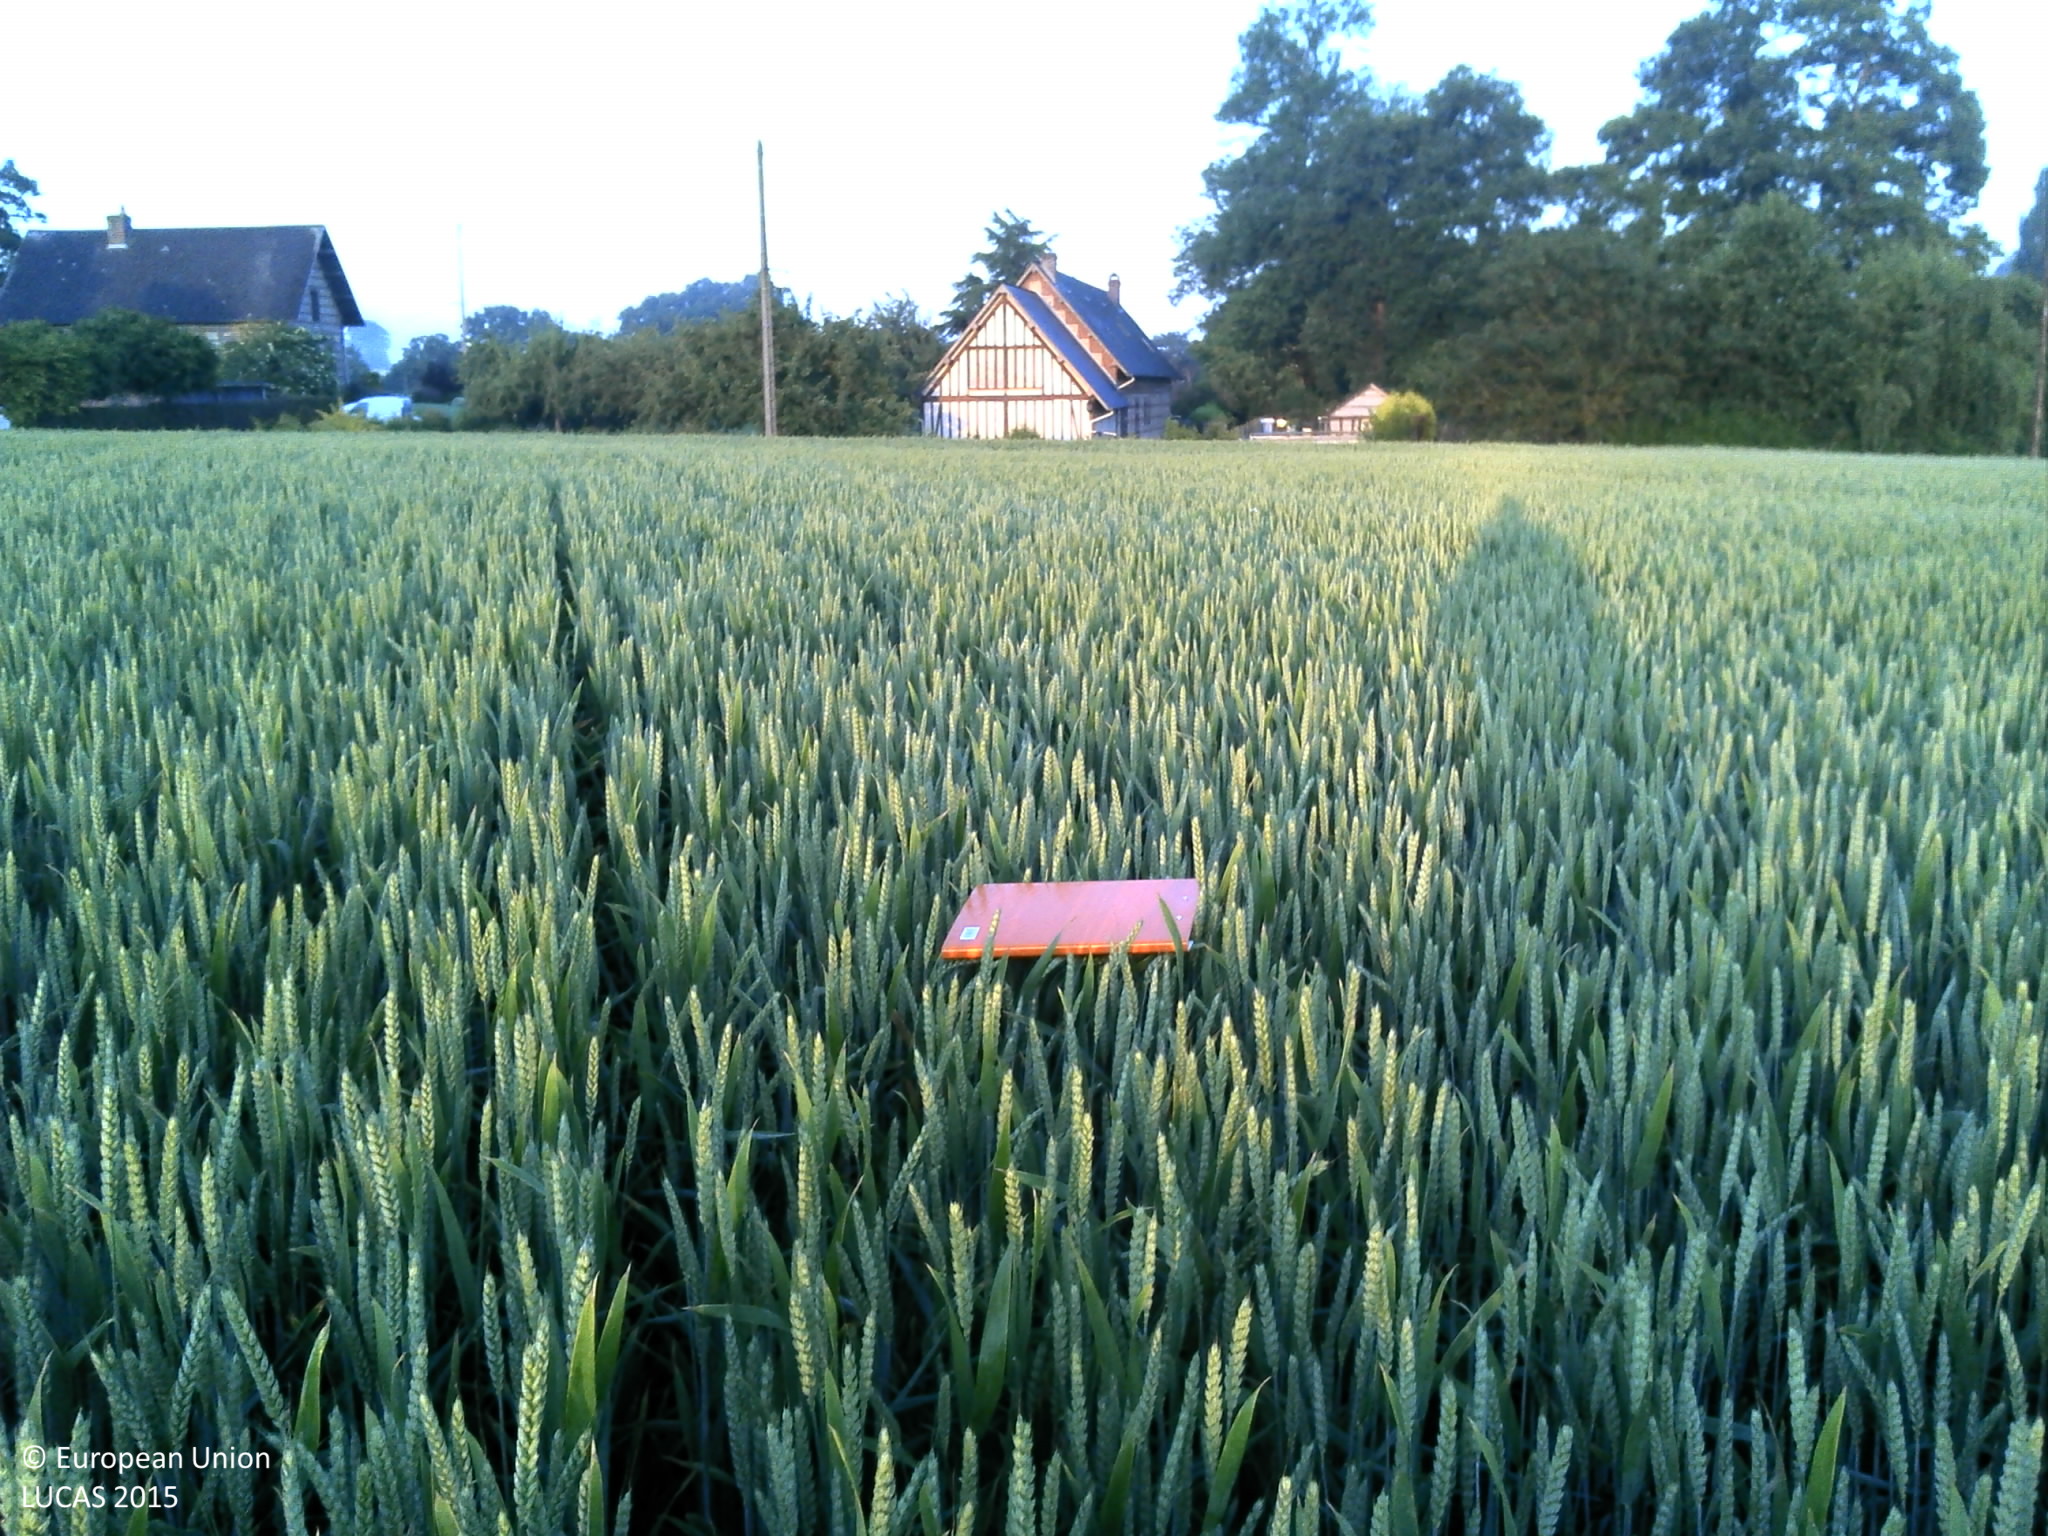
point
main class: Cropland
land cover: Common wheat
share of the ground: > 75 %
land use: Agriculture (excluding fallow land and kitchen gardens)
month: June
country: FR
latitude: 49.5330
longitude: 0.2853
